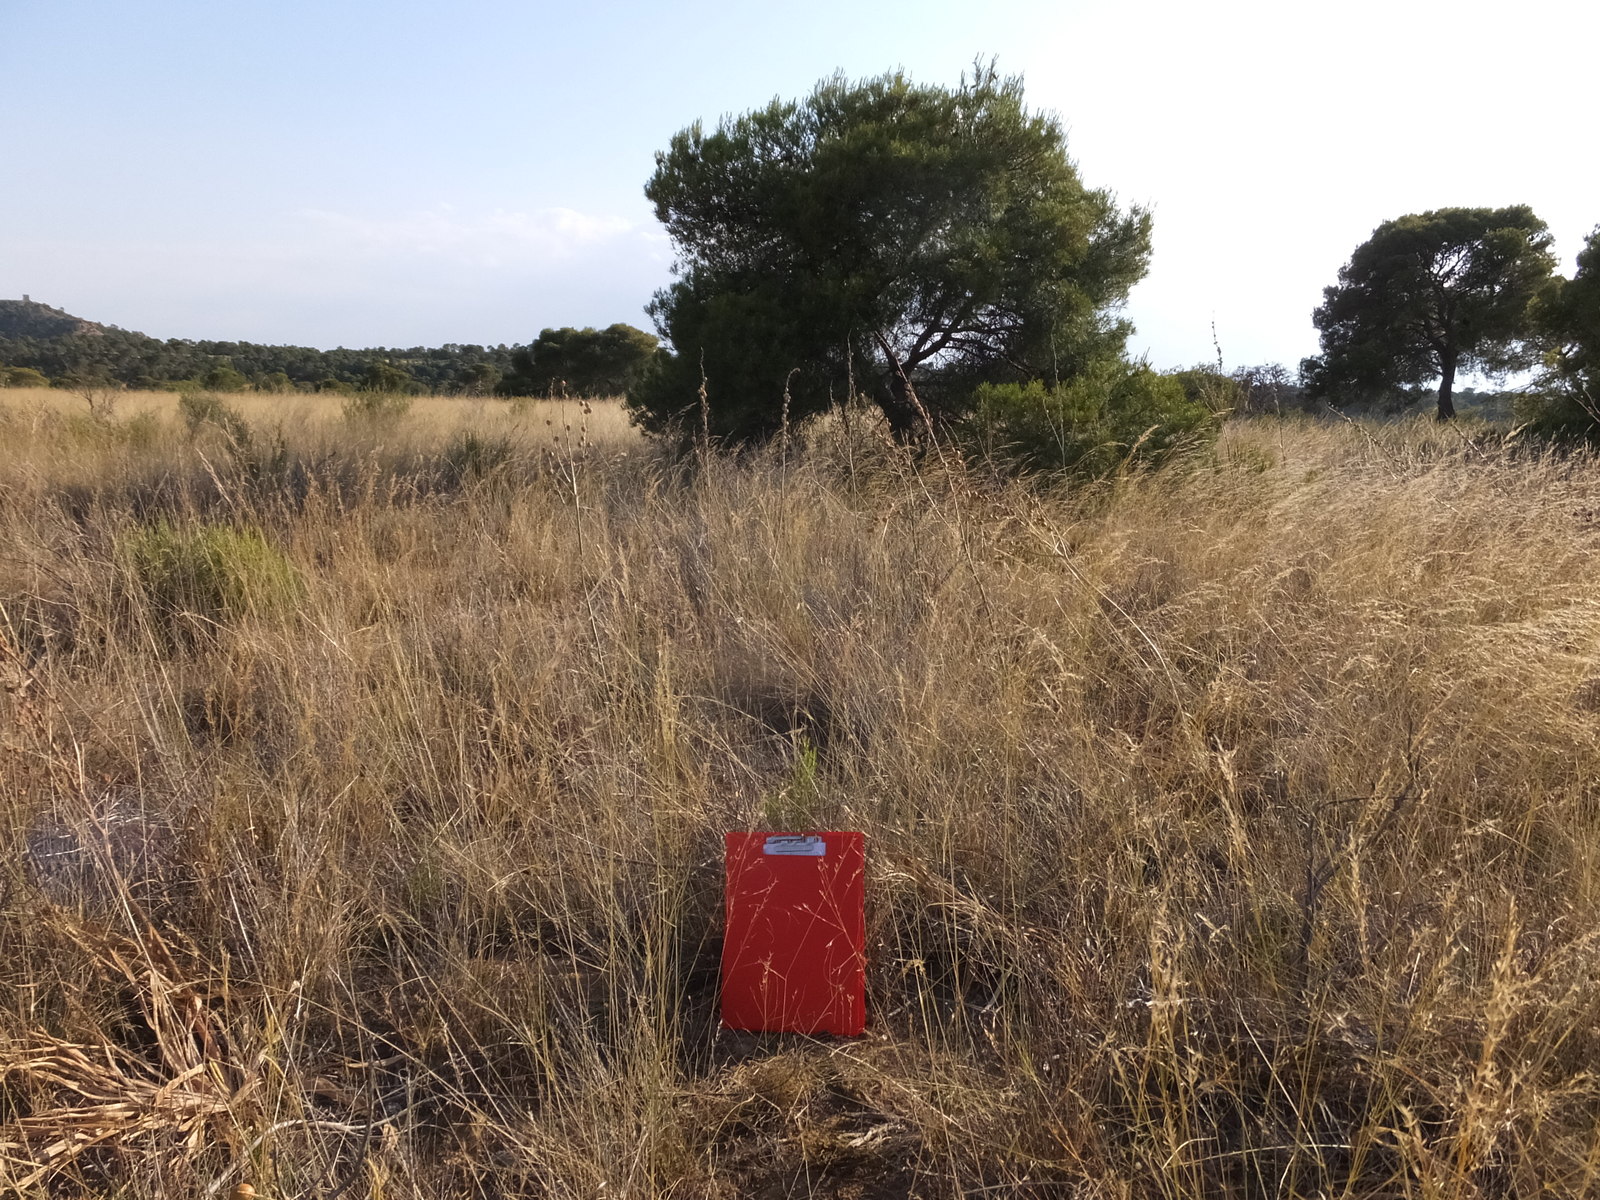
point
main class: Grassland
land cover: Grassland with sparse tree/shrub cover
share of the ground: > 75 %
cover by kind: herbaceous plants 85 %, shrubs 10 %, coniferous forest trees 5 %
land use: Abandoned areas
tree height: > 5 m
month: June
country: ES
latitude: 41.2779
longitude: -0.2456
